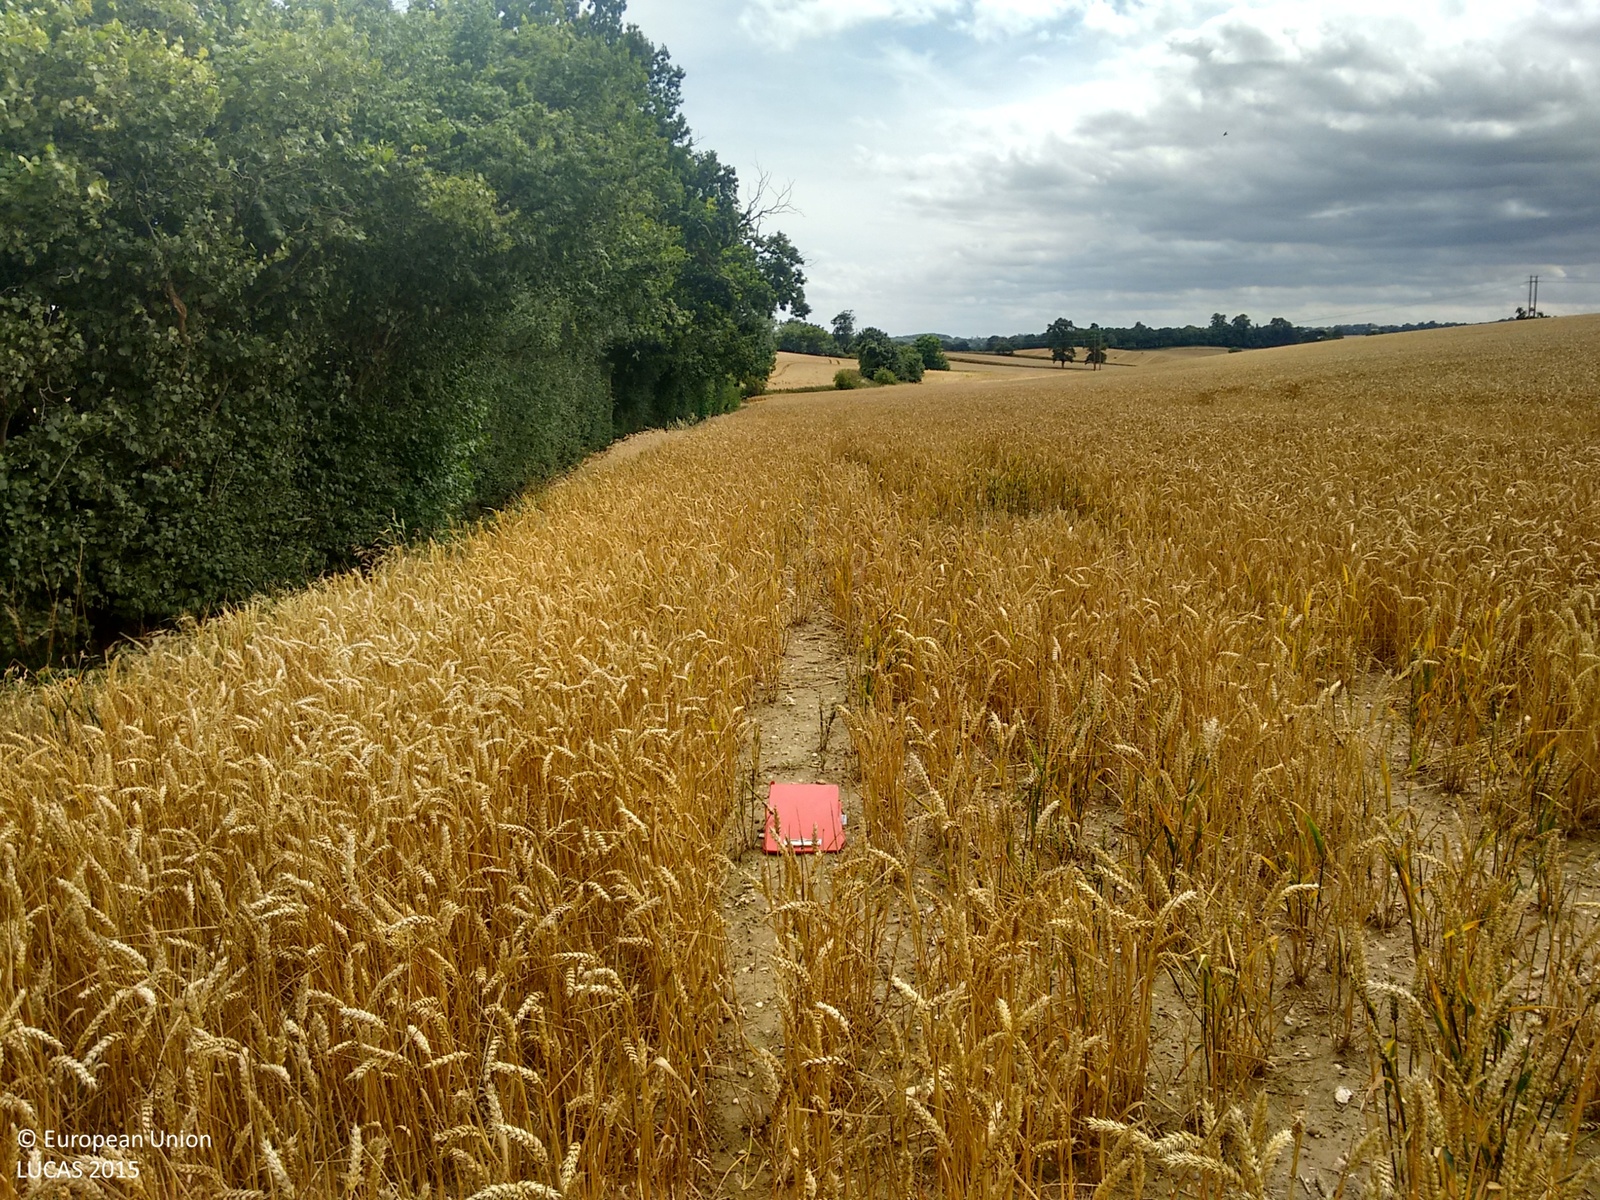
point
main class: Cropland
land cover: Common wheat
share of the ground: 50 - 75 %
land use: Agriculture (excluding fallow land and kitchen gardens)
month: August
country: GB
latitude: 51.9594
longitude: 0.4985
